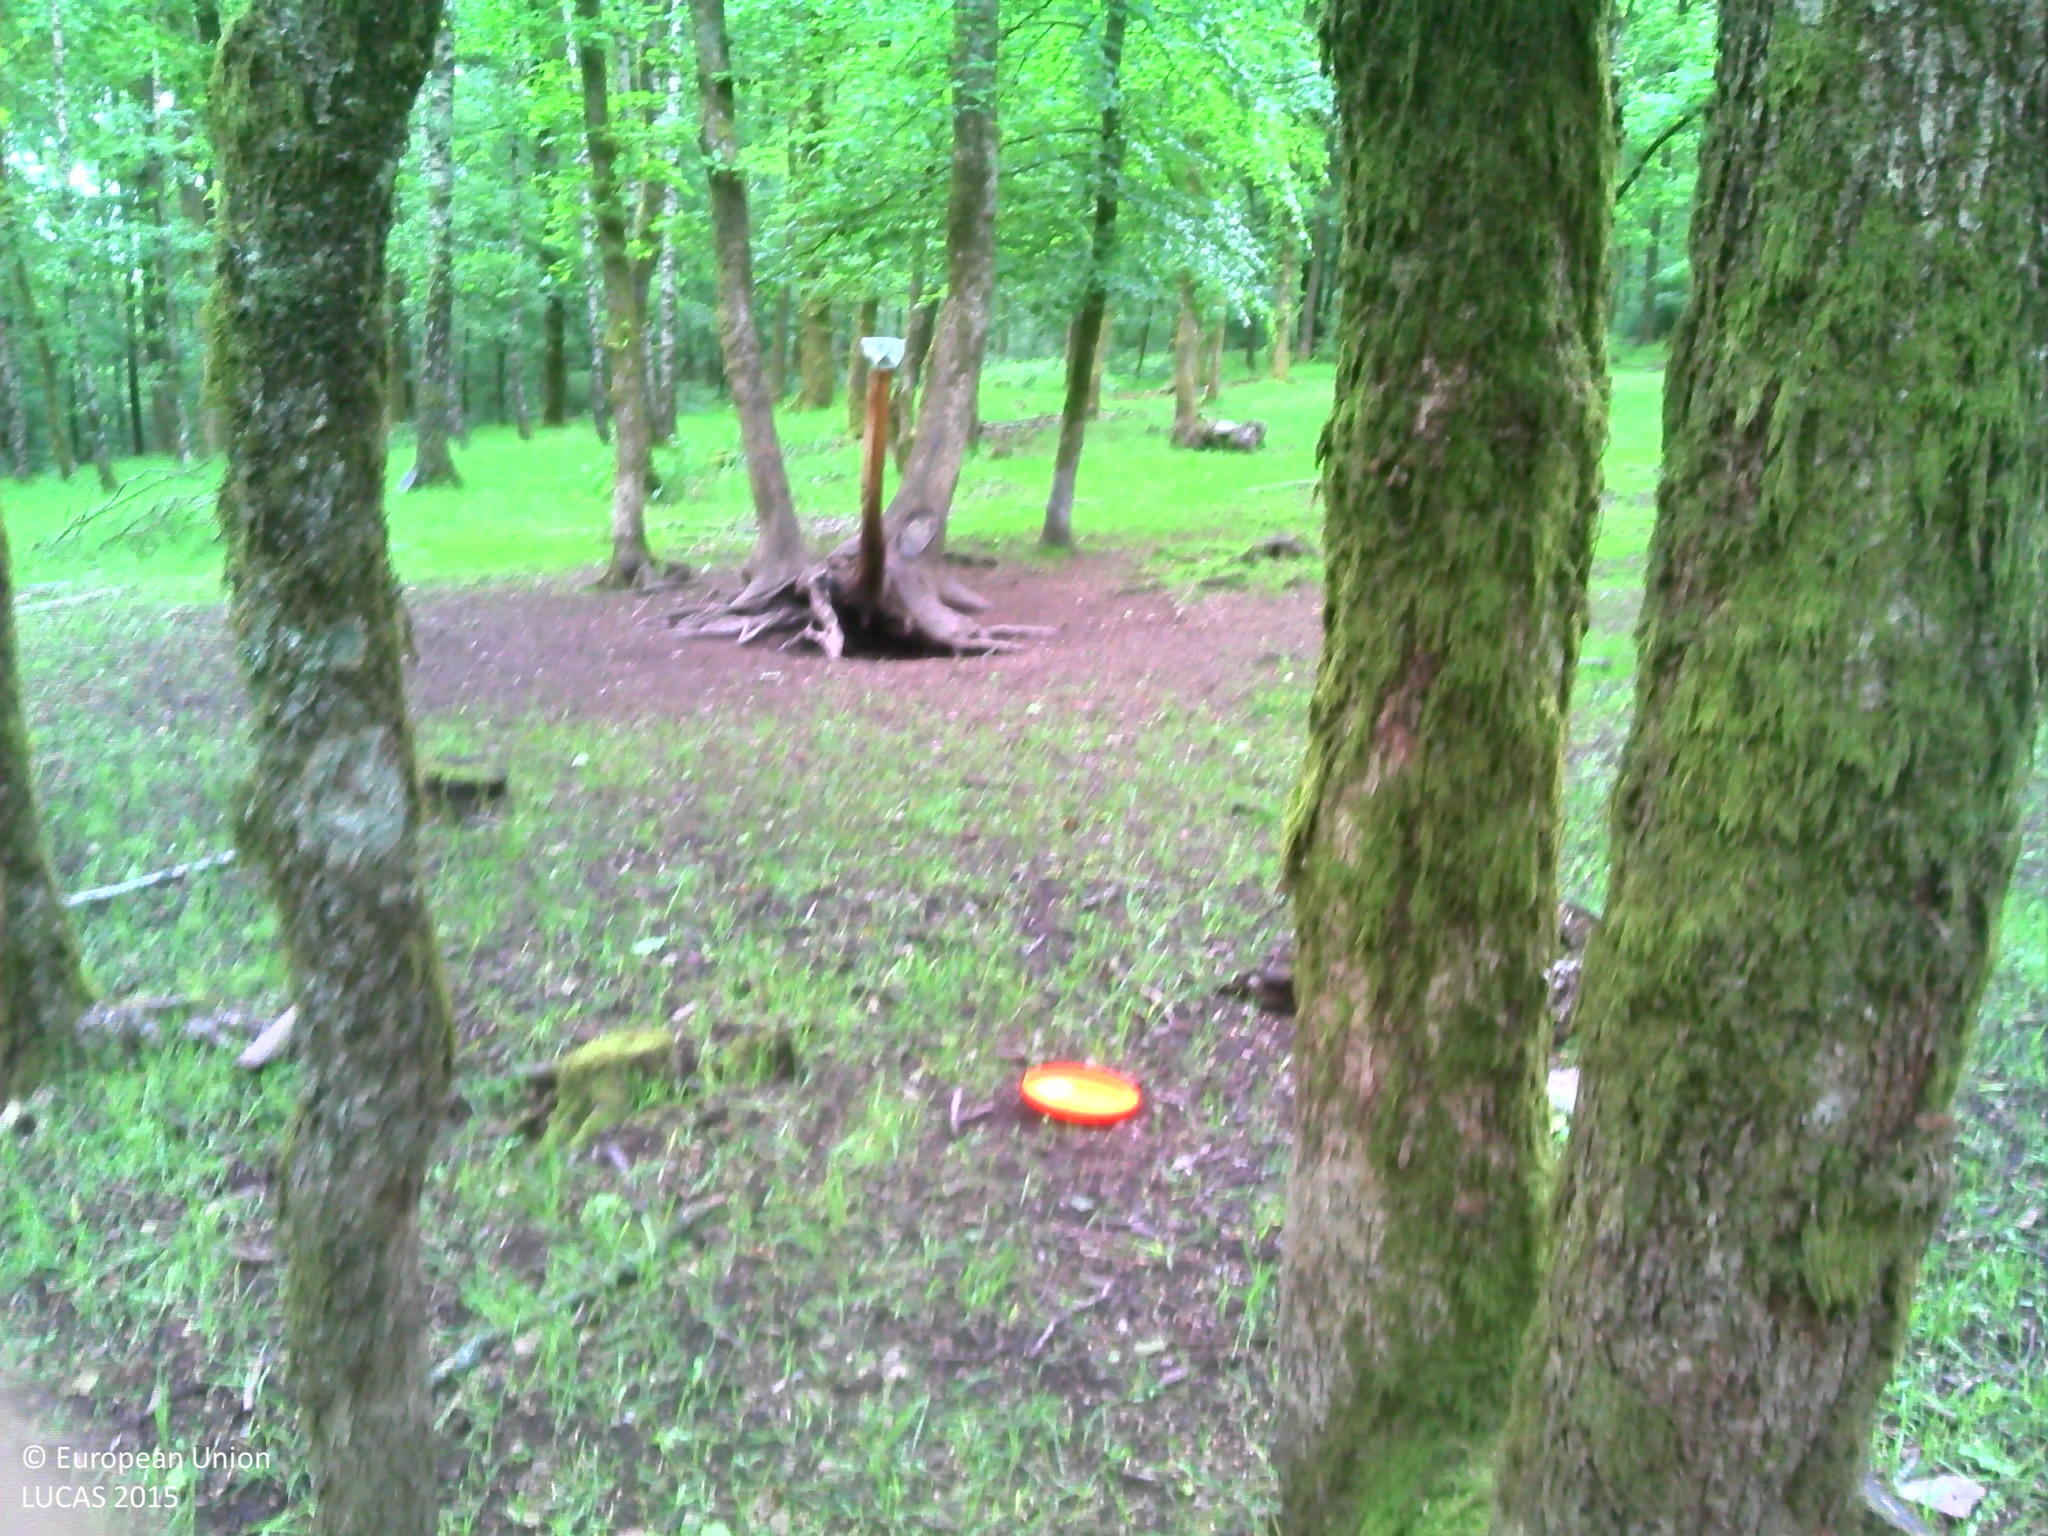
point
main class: Woodland
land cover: Broadleaved woodland
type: acidophilous oak and oak-birch forest
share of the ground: > 75 %
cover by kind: broadleaved forest trees 85 %, herbaceous plants 10 %, unconsolidated bare surface 5 %
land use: Forestry
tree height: > 5 m
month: June
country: BE
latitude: 49.8190
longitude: 4.9241
